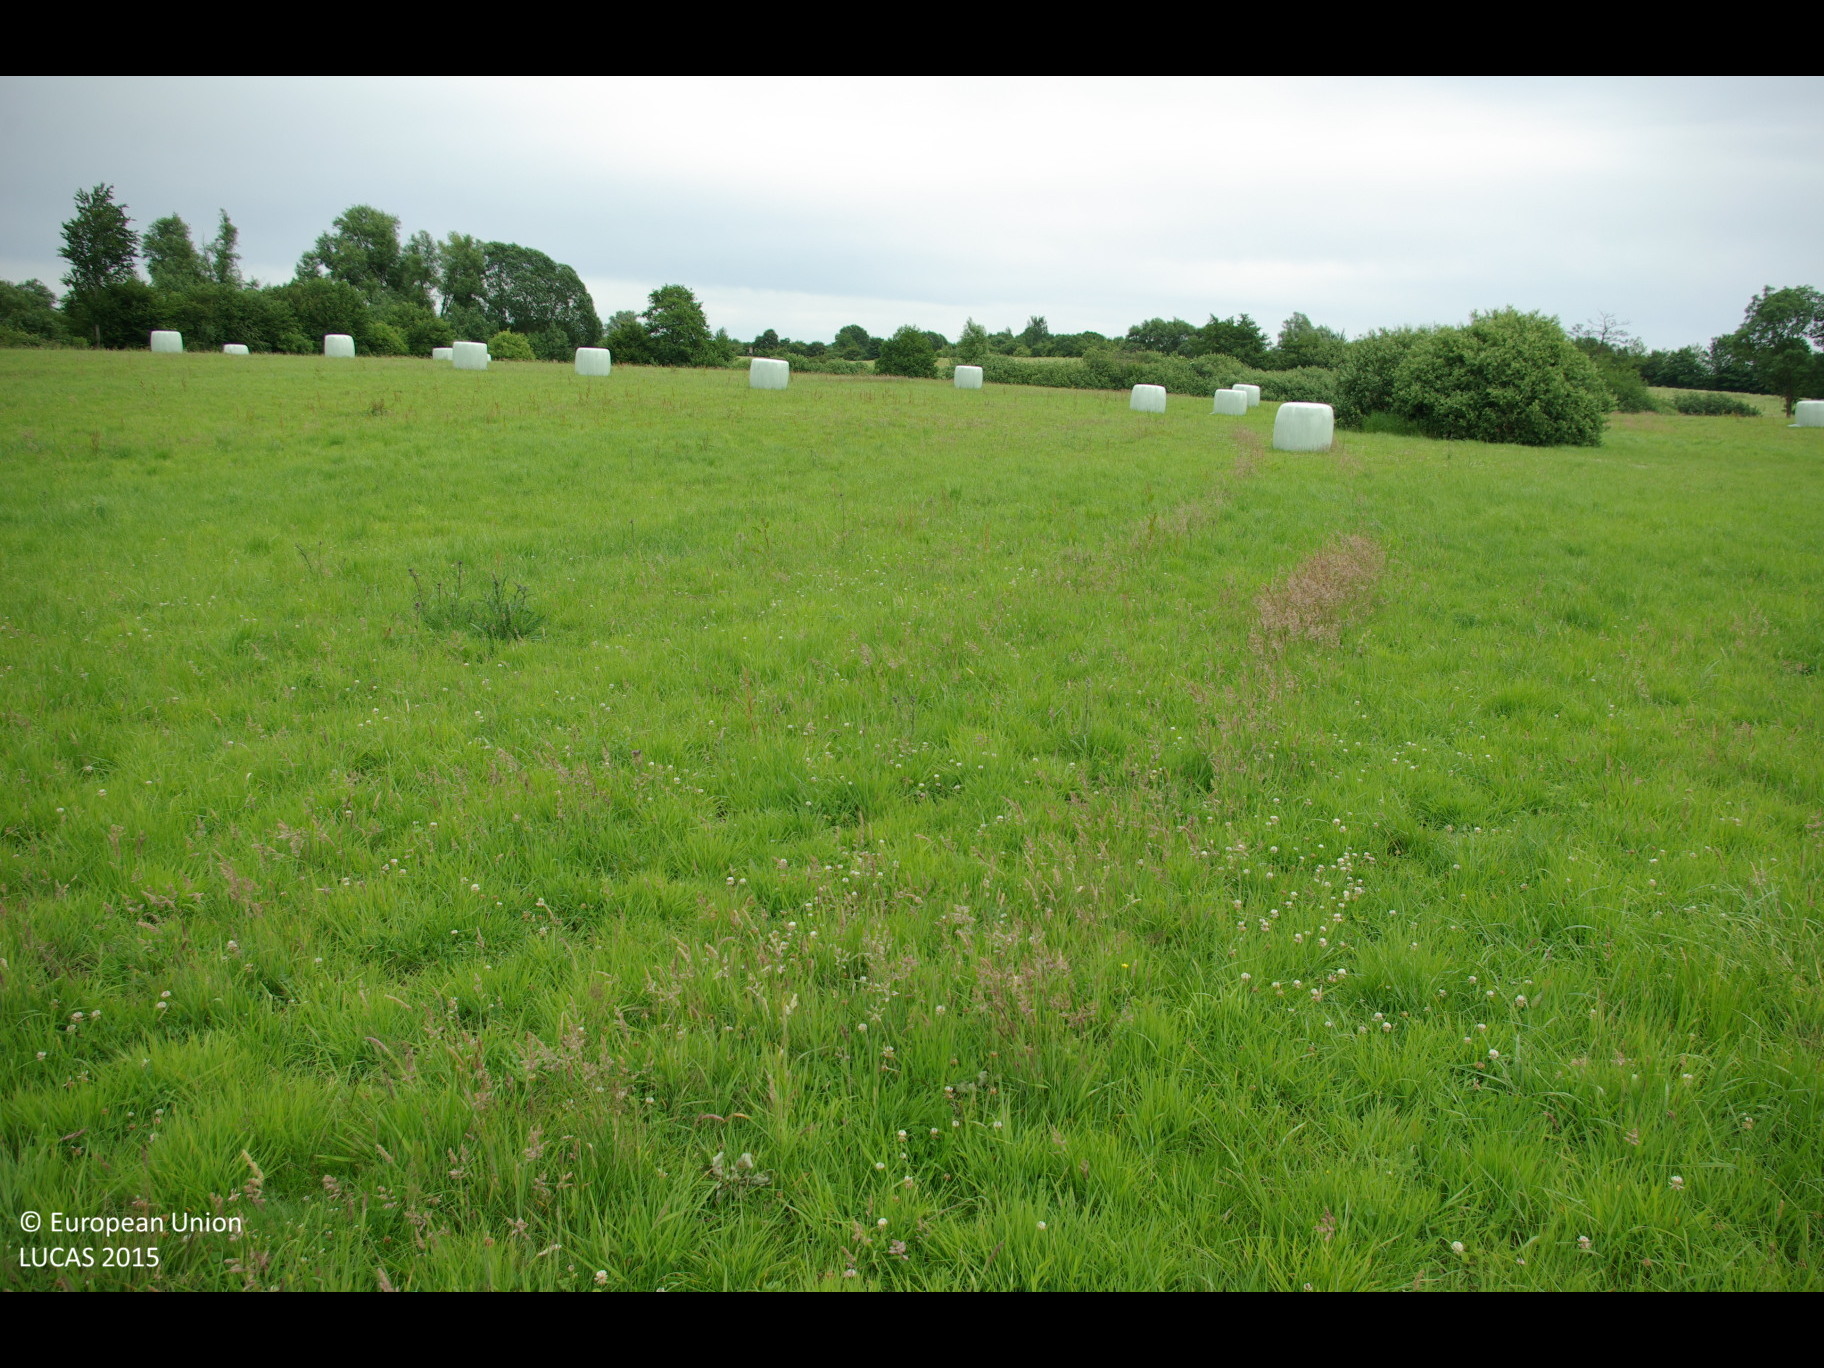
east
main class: Grassland
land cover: Grassland without tree/shrub cover
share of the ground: > 75 %
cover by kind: herbaceous plants 100 %
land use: Agriculture (excluding fallow land and kitchen gardens)
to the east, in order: Grassland without tree/shrub cover; Shrubland with sparse tree cover; Ditches and canals; Shrubland with sparse tree cover; Fences; Grassland without tree/shrub cover; Fences; Grass margins; Ditches and canals; Spontaneously vegetated surfaces; Mixed cereals for fodder
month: July
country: DE
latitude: 54.1192
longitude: 10.6269
